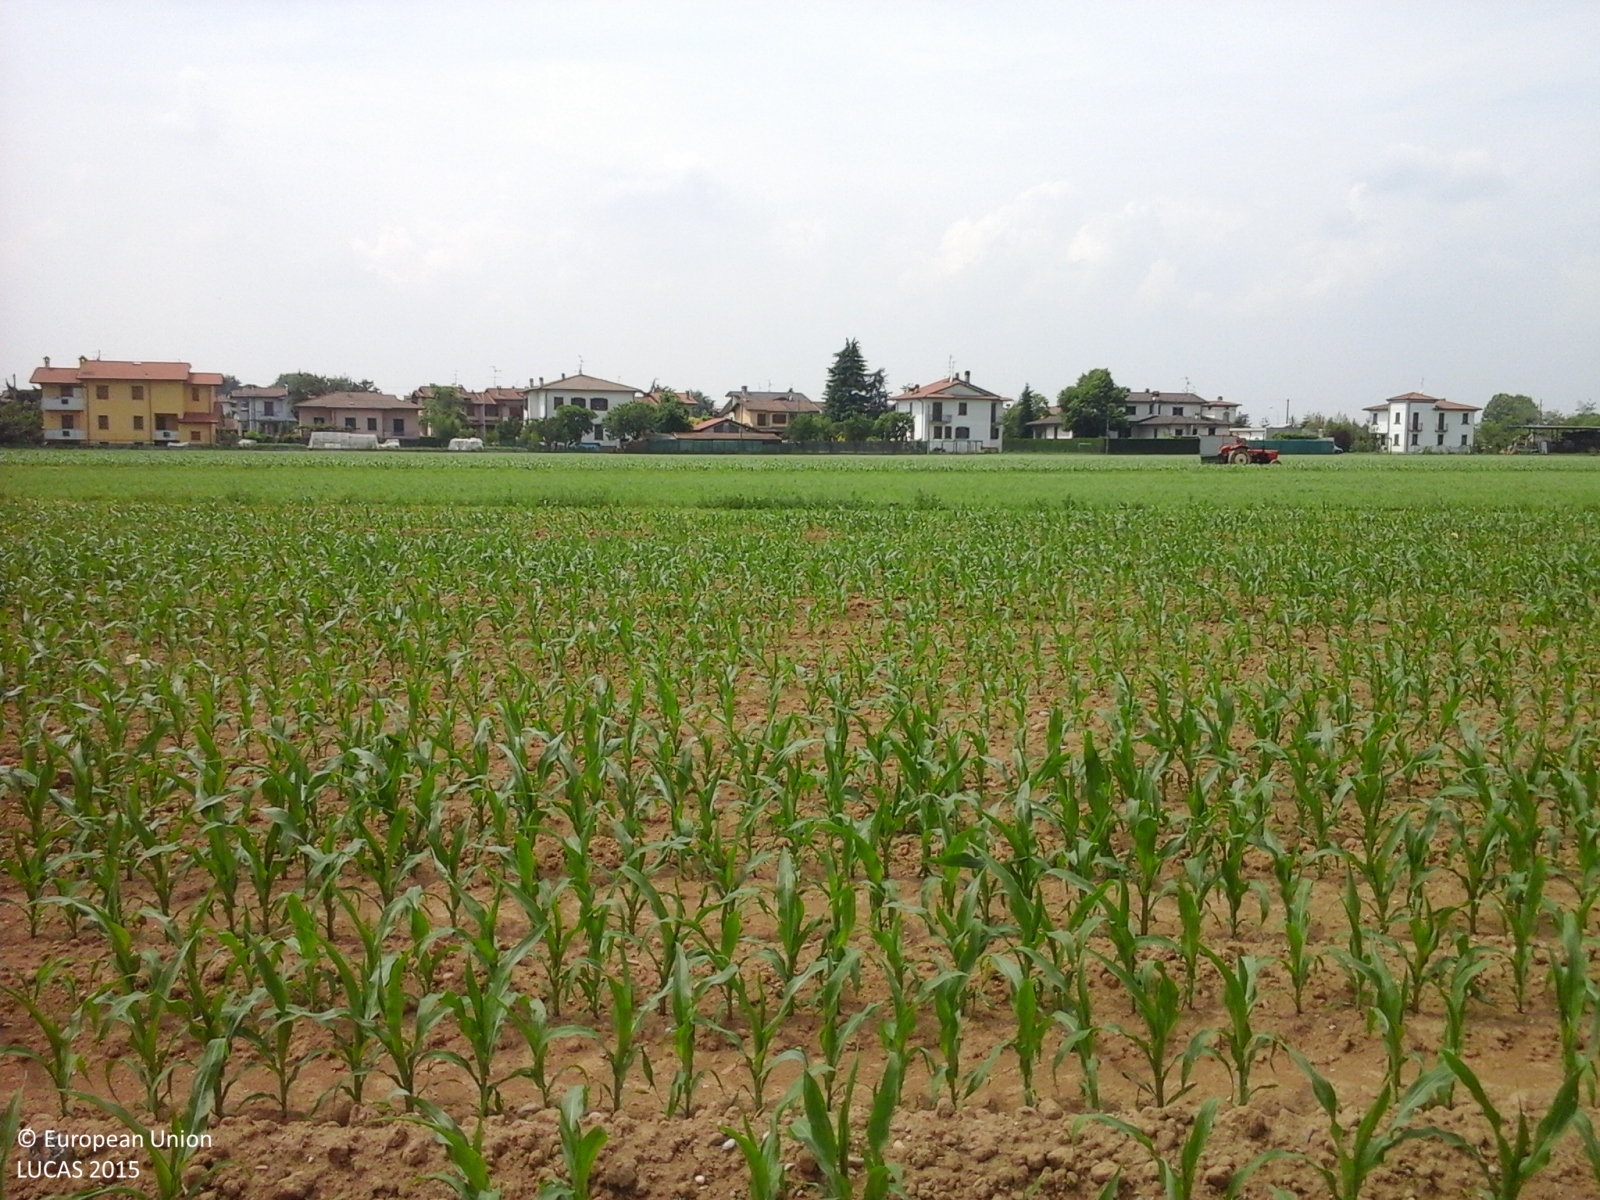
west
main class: Cropland
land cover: Maize
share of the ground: < 10 %
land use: Agriculture (excluding fallow land and kitchen gardens)
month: May
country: IT
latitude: 45.5578
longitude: 9.6291
